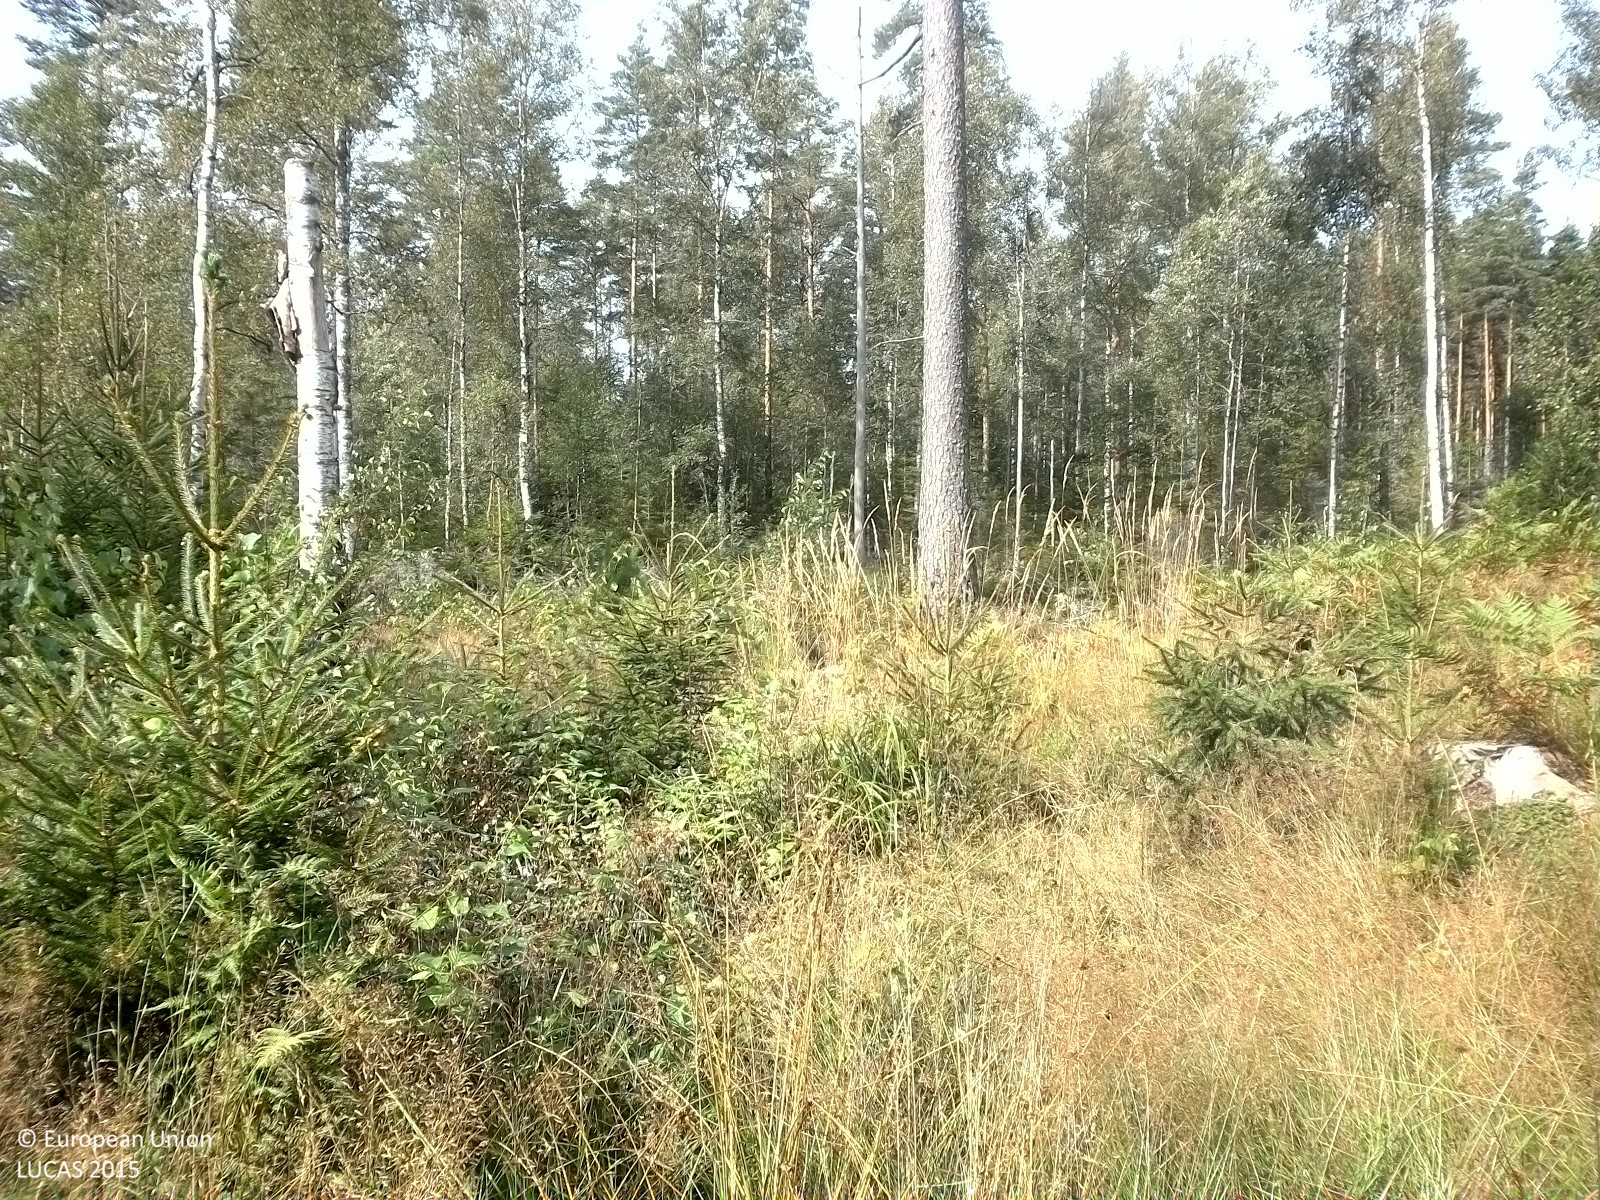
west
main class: Woodland
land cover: Spruce dominated mixed woodland
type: boreal forest
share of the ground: 25 - 50 %
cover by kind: herbaceous plants 45 %, coniferous forest trees 20 %, broadleaved forest trees 15 %, shrubs 10 %, lichens and mosses 10 %
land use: Forestry
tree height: < 5 m
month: August
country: SE
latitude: 58.8456
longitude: 15.5214
